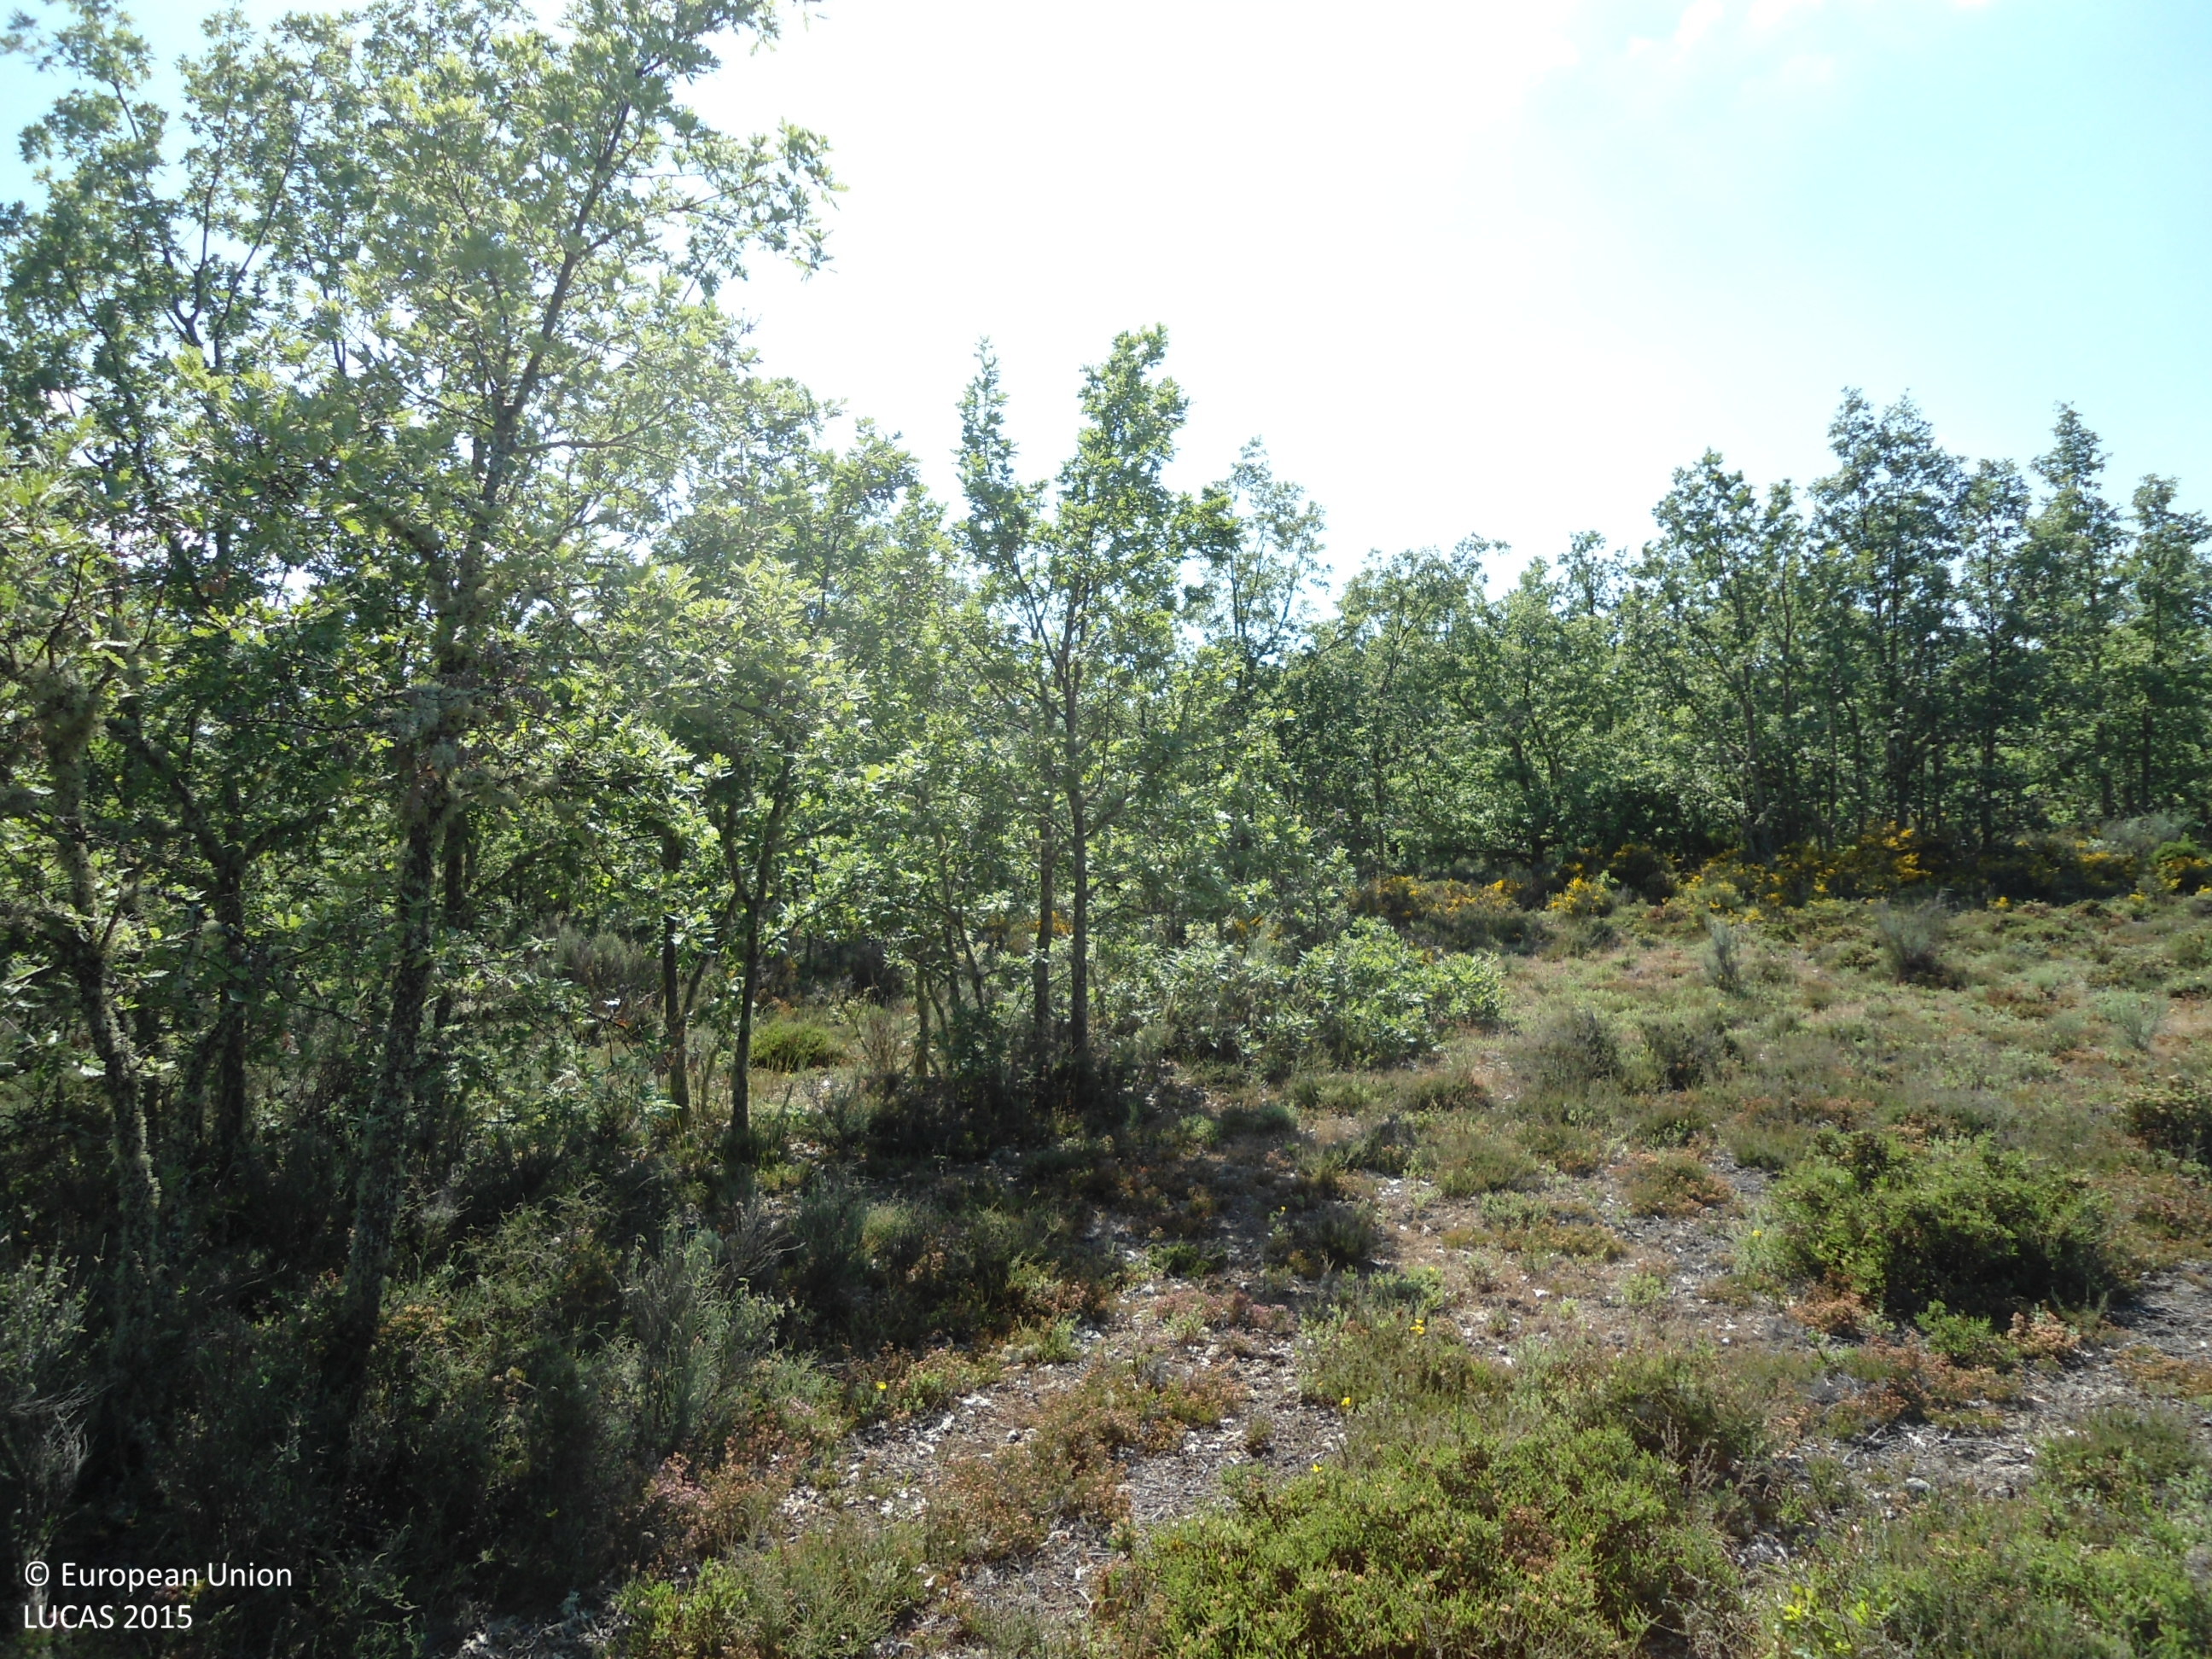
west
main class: Woodland
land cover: Broadleaved woodland
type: thermophilous deciduous forest
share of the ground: 50 - 75 %
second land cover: Shrubland without tree cover
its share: 50 - 75 %
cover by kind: broadleaved forest trees 50 %, shrubs 50 %
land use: Forestry
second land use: Agriculture (excluding fallow land and kitchen gardens)
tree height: > 5 m
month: June
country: ES
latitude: 42.1059
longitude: -6.3485
